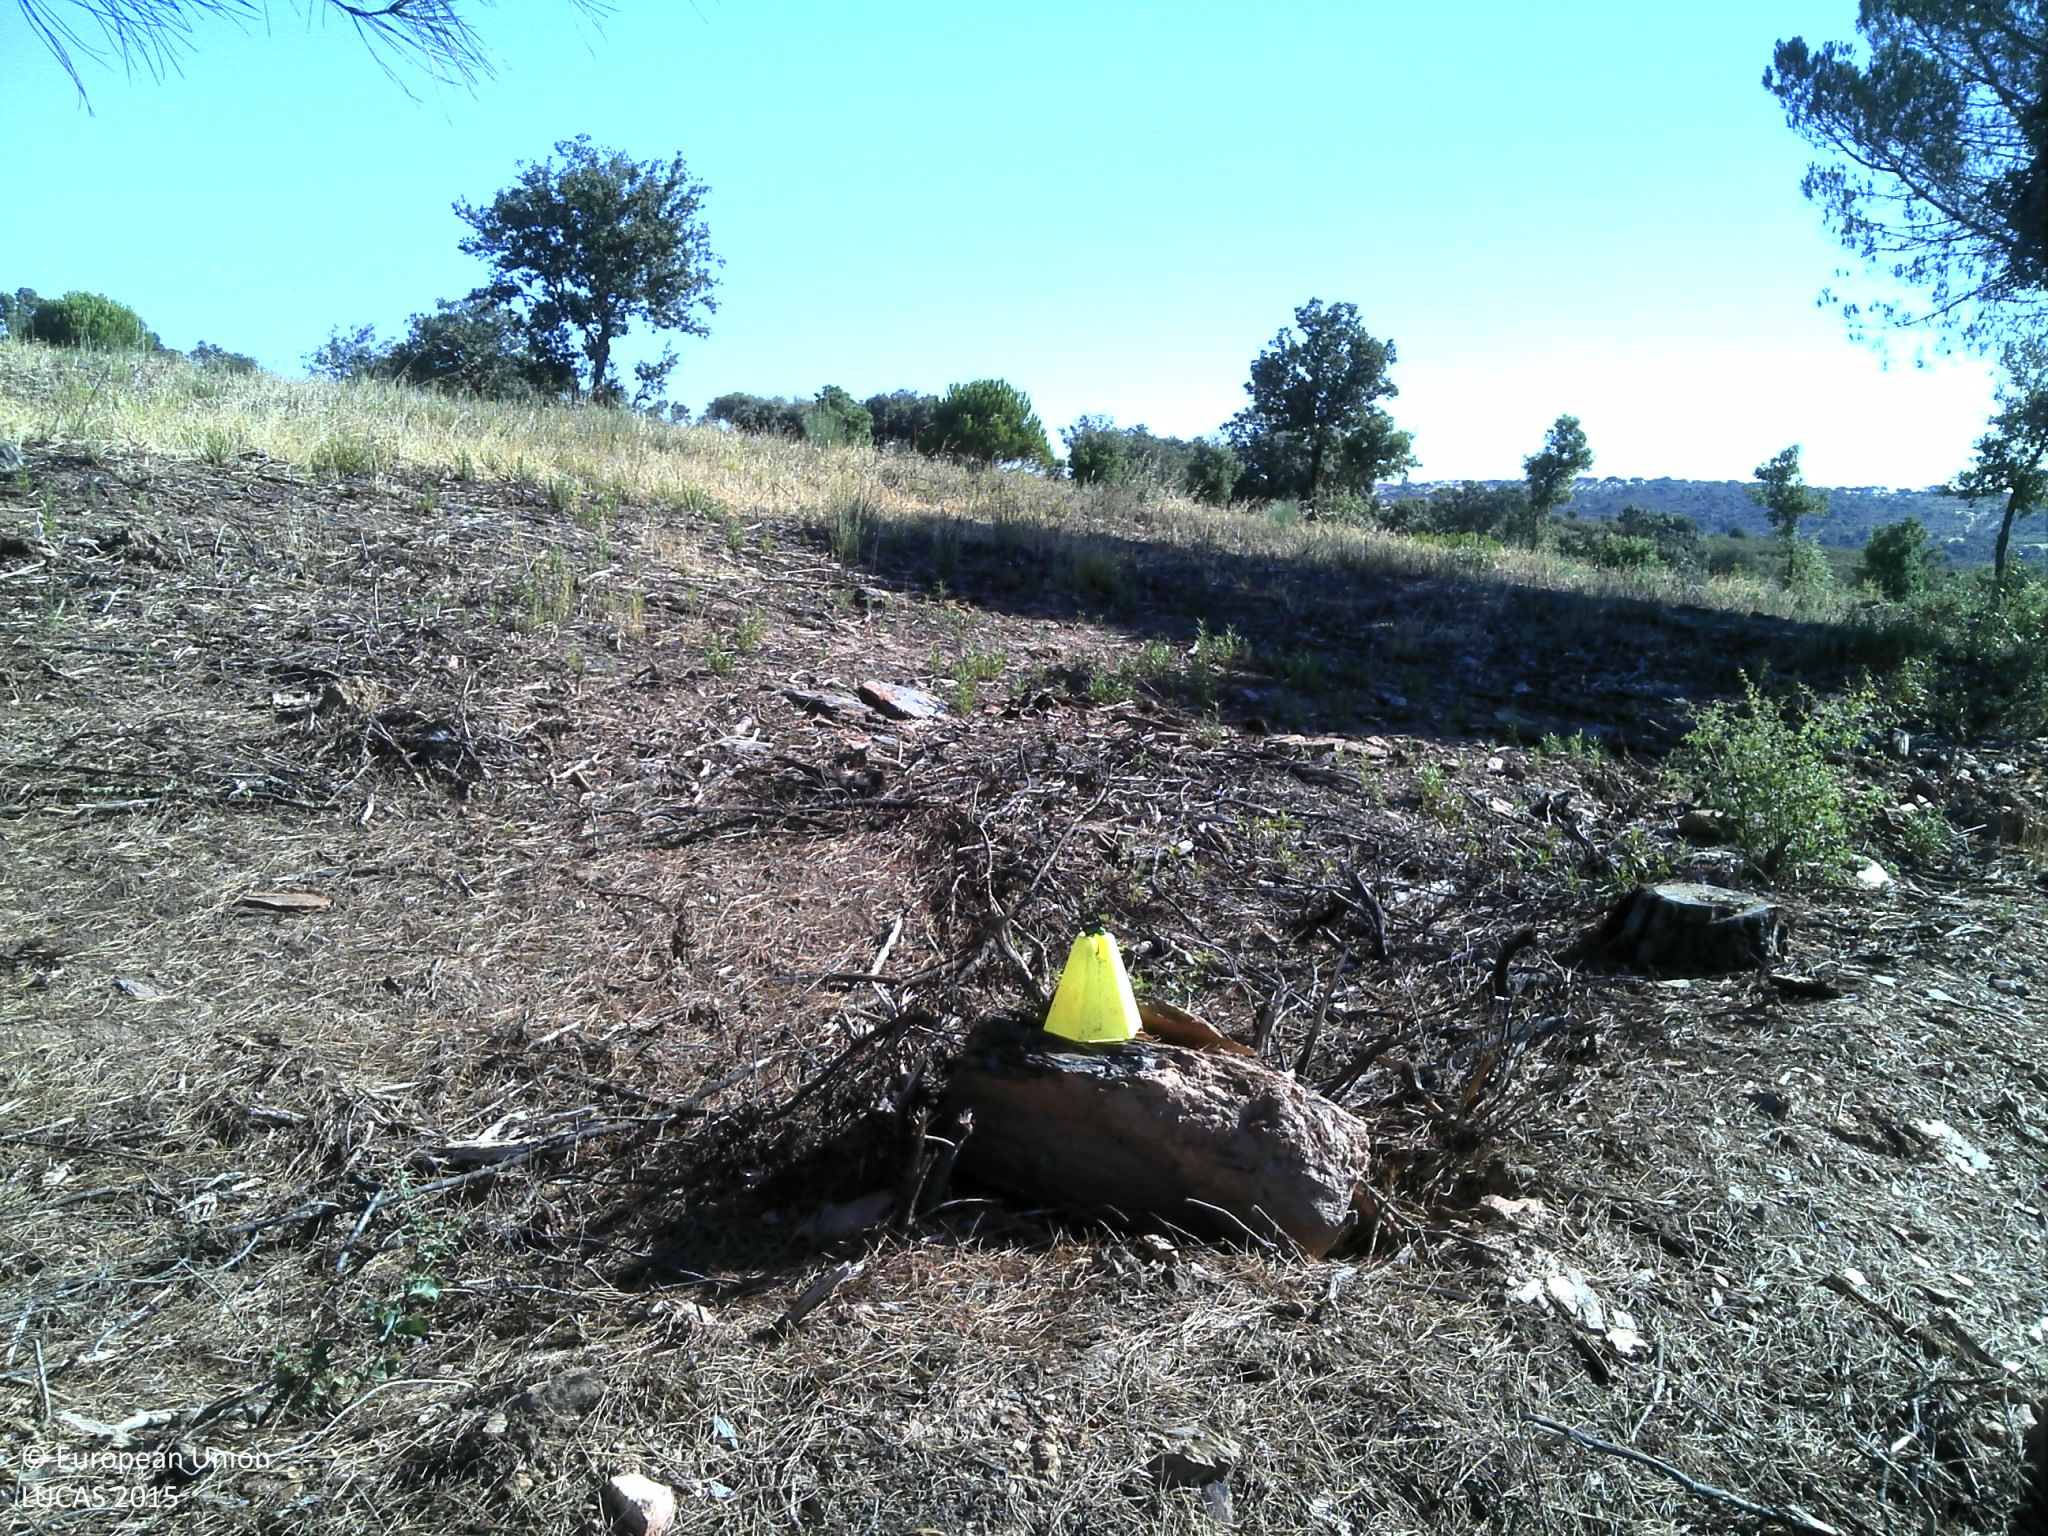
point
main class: Woodland
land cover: Pine dominated coniferous woodland
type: coniferous forest of the mediterranean region
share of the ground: 10 - 25 %
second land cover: Grassland without tree/shrub cover
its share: 25 - 50 %
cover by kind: unconsolidated bare surface 55 %, coniferous forest trees 25 %, herbaceous plants 20 %
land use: Forestry
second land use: Agriculture (excluding fallow land and kitchen gardens)
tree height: > 5 m
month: July
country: PT
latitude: 38.9364
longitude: -7.5146
